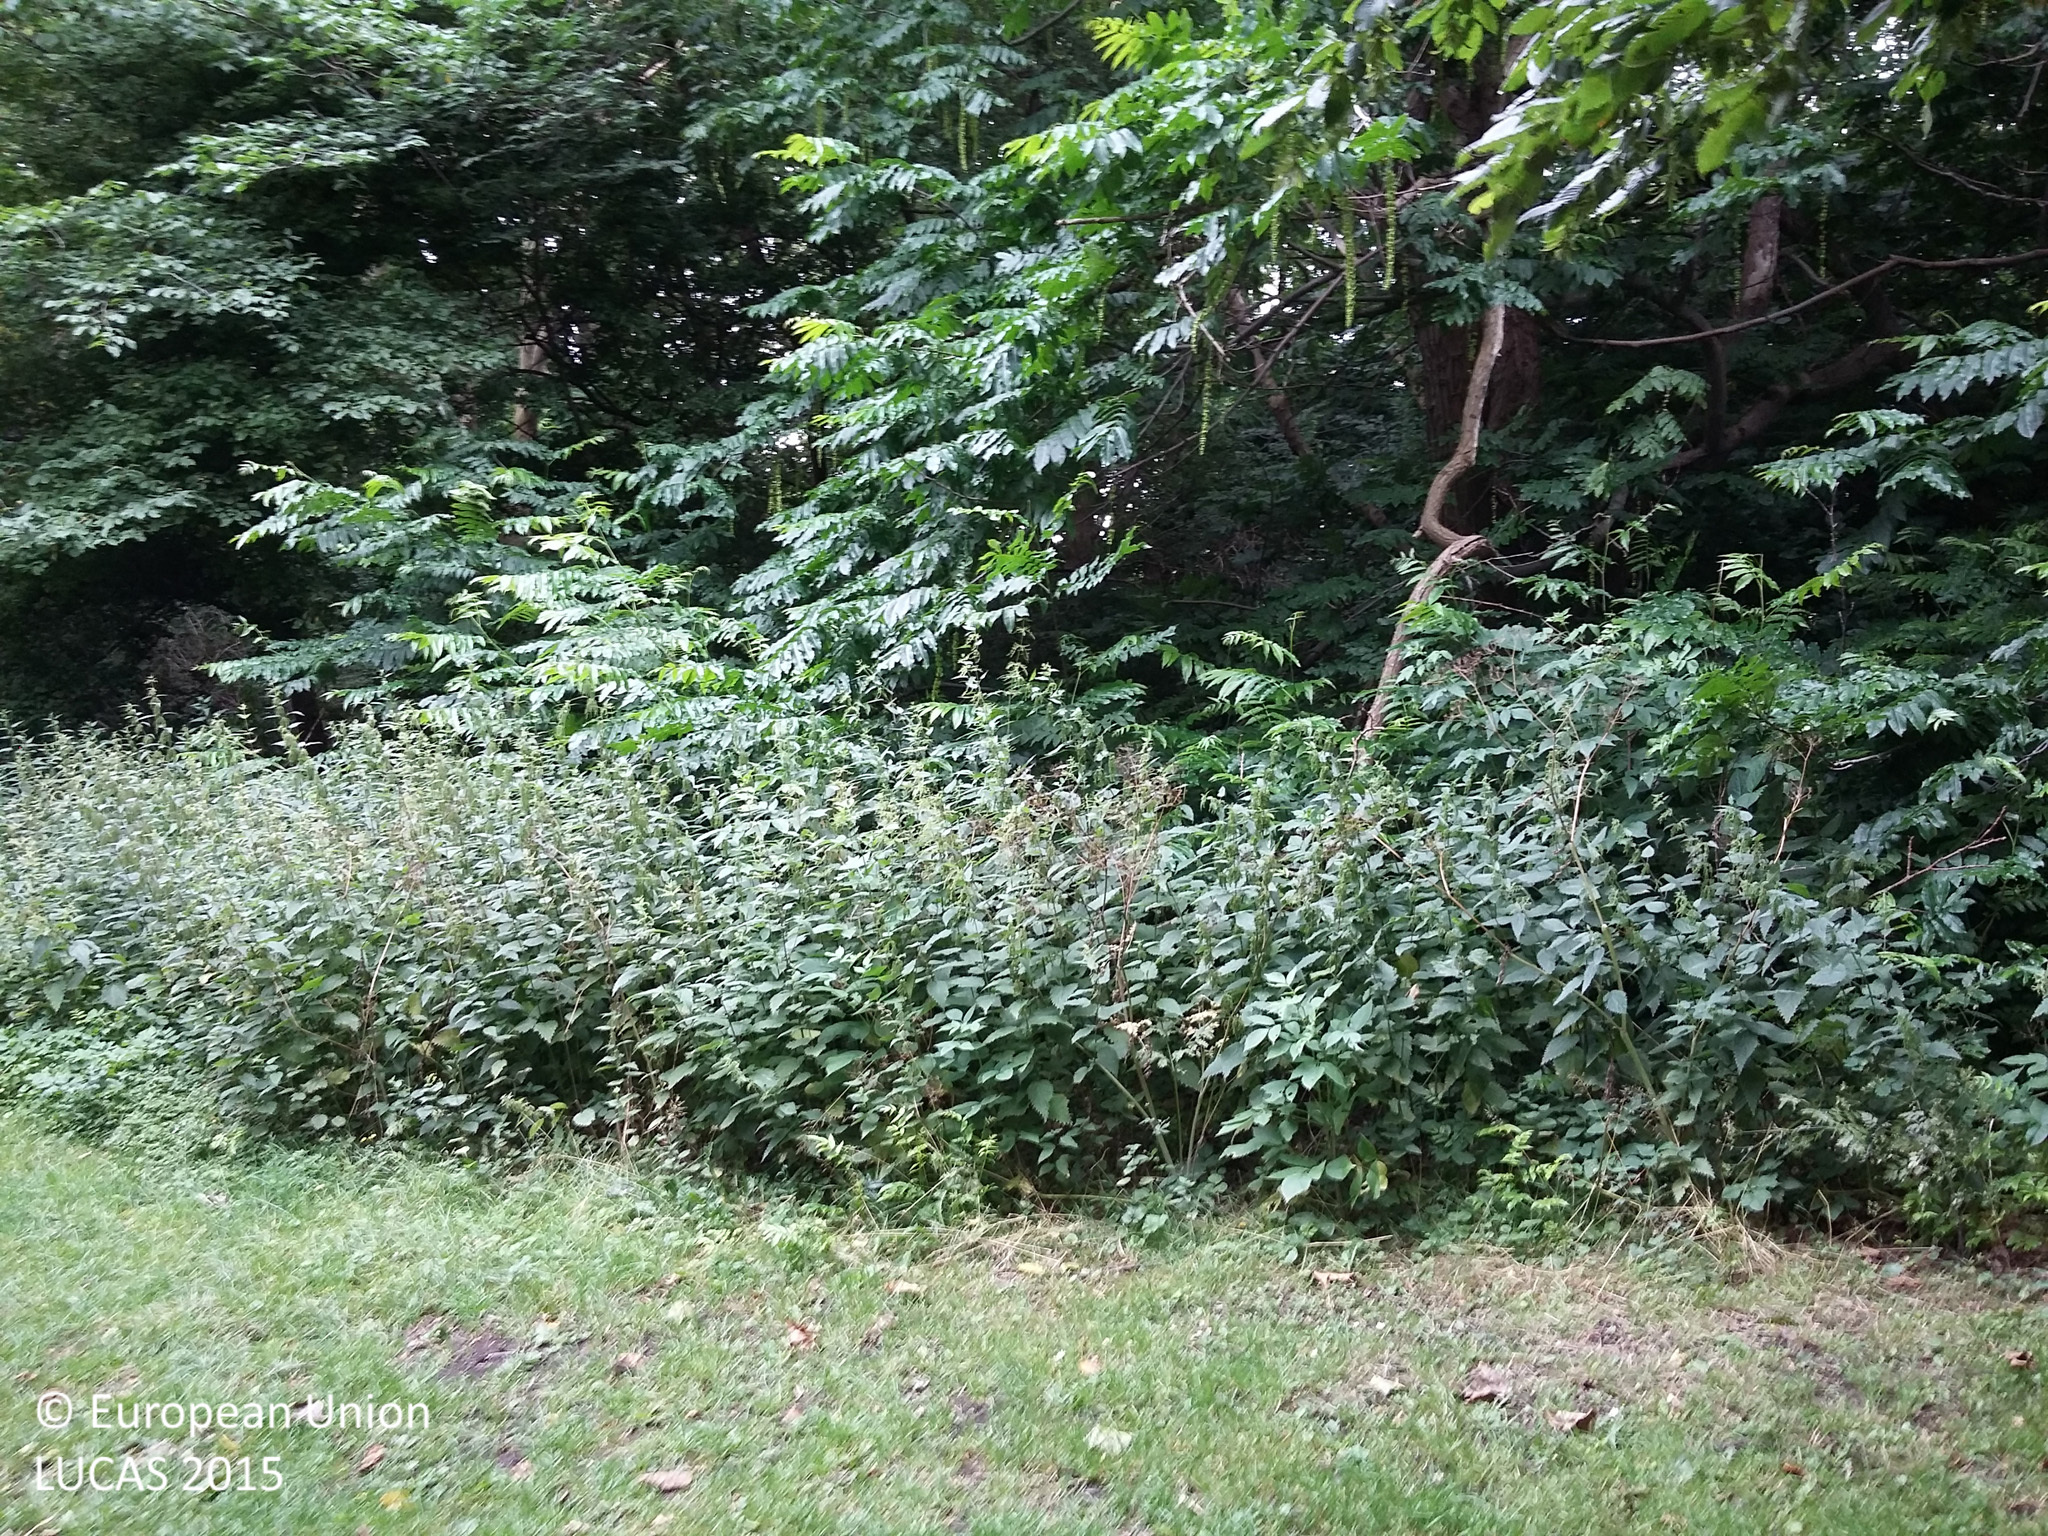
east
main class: Woodland
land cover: Broadleaved woodland
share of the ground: > 75 %
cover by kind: broadleaved forest trees 70 %, herbaceous plants 30 %
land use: Amenities, museums, leisure
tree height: > 5 m
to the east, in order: Broadleaved woodland; Grassland without tree/shrub cover; Ditches and canals; Grass margins; Paved roads, cycling and walking lanes; Grass margins; Ditches and canals; Grass margins; Broadleaved woodland; Tracks; Broadleaved woodland; Fences; Inland fresh running water; Artificial constructions in urban areas
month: July
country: DK
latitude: 55.6414
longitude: 12.5242
